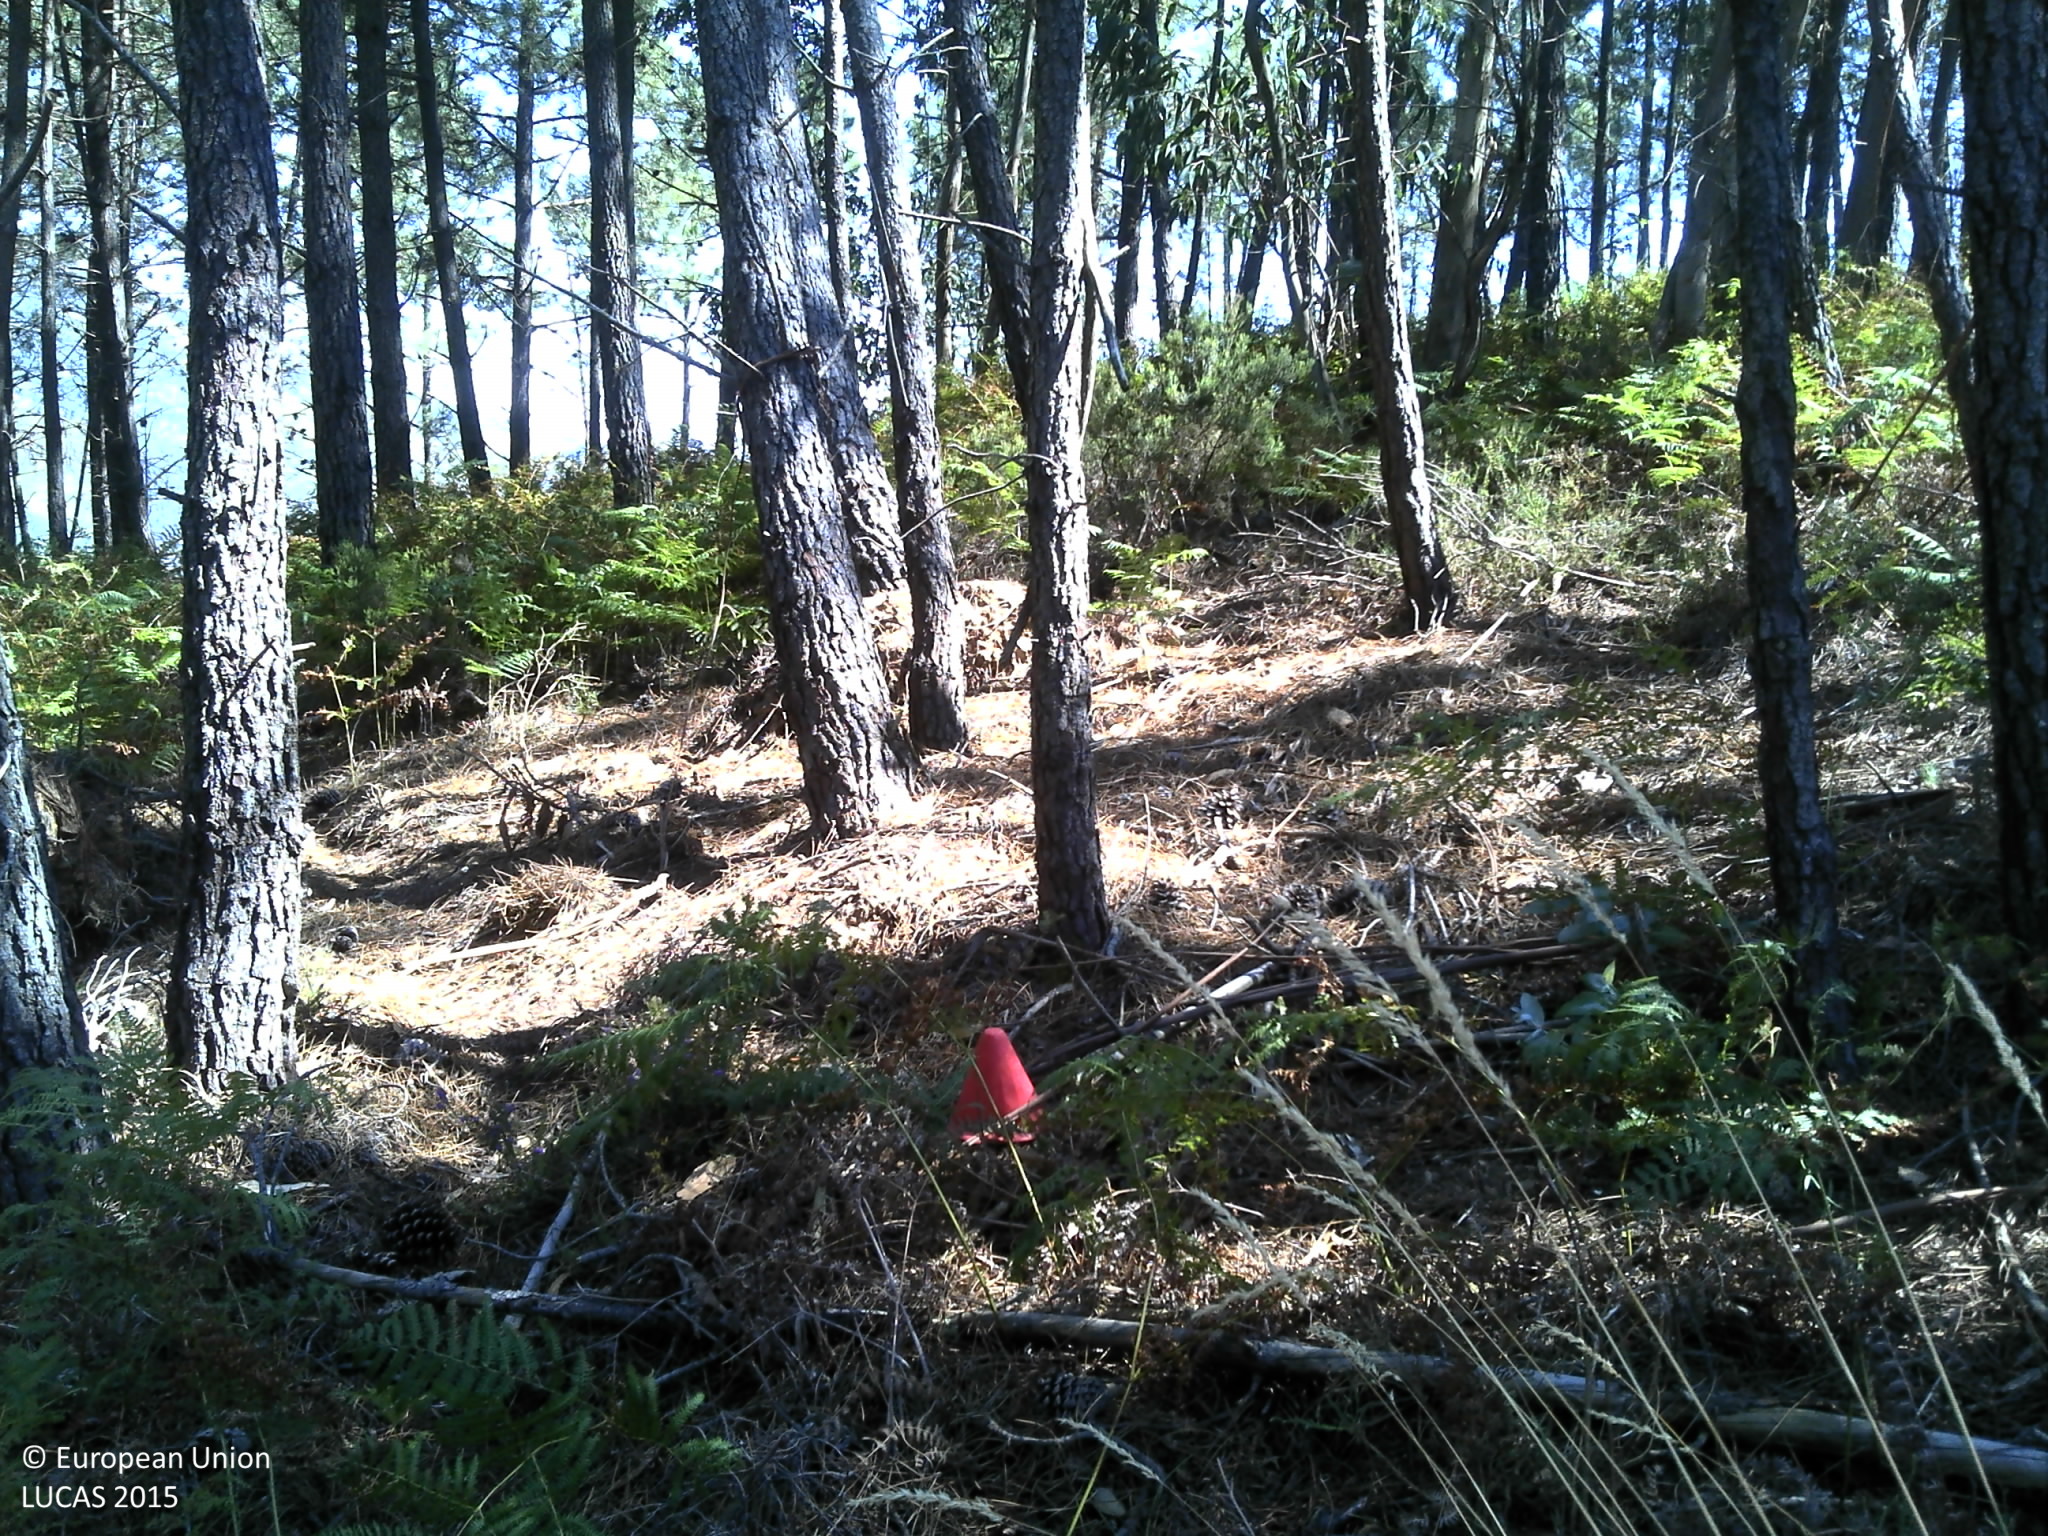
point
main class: Woodland
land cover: Pine dominated coniferous woodland
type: coniferous forest of the mediterranean region
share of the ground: 25 - 50 %
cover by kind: coniferous forest trees 45 %, unconsolidated bare surface 45 %, herbaceous plants 10 %
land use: Forestry
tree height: > 5 m
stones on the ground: < 10 %
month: June
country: PT
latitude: 40.0840
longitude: -8.0977
